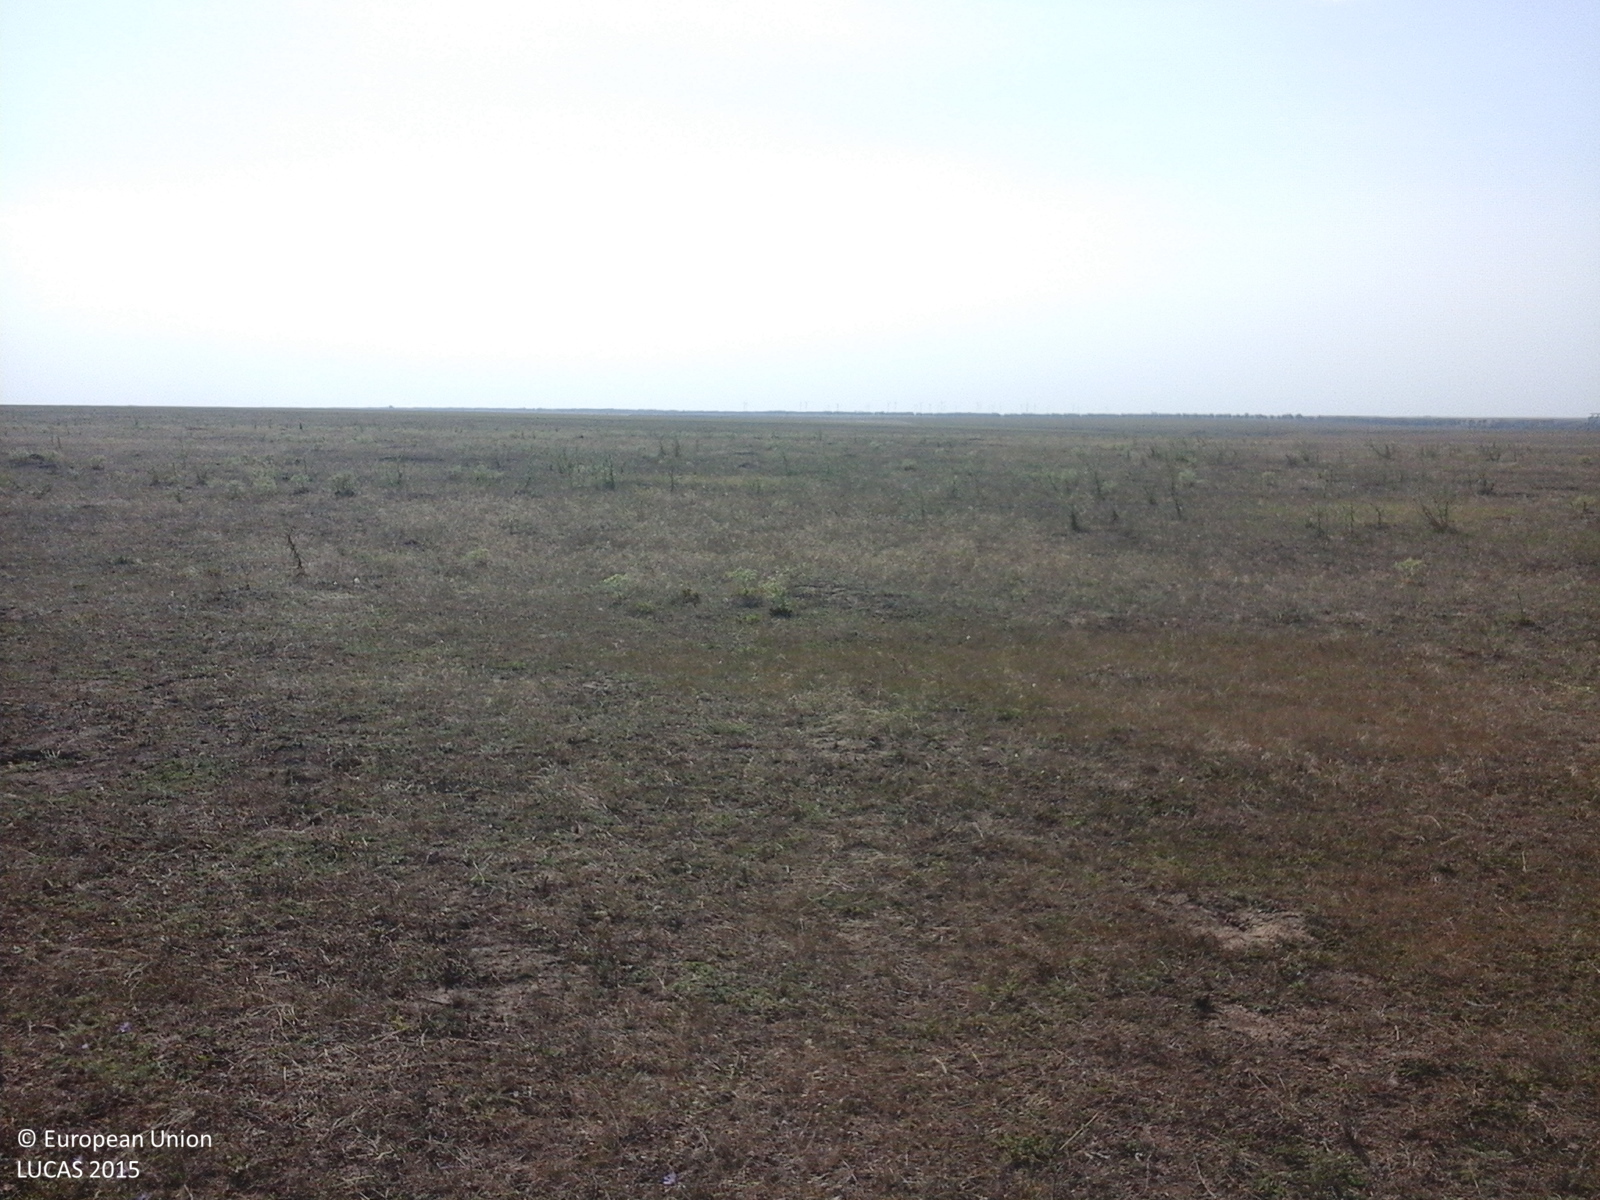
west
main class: Grassland
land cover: Grassland without tree/shrub cover
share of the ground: > 75 %
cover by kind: herbaceous plants 100 %
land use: Agriculture (excluding fallow land and kitchen gardens)
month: August
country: RO
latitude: 43.8794
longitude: 28.3442
